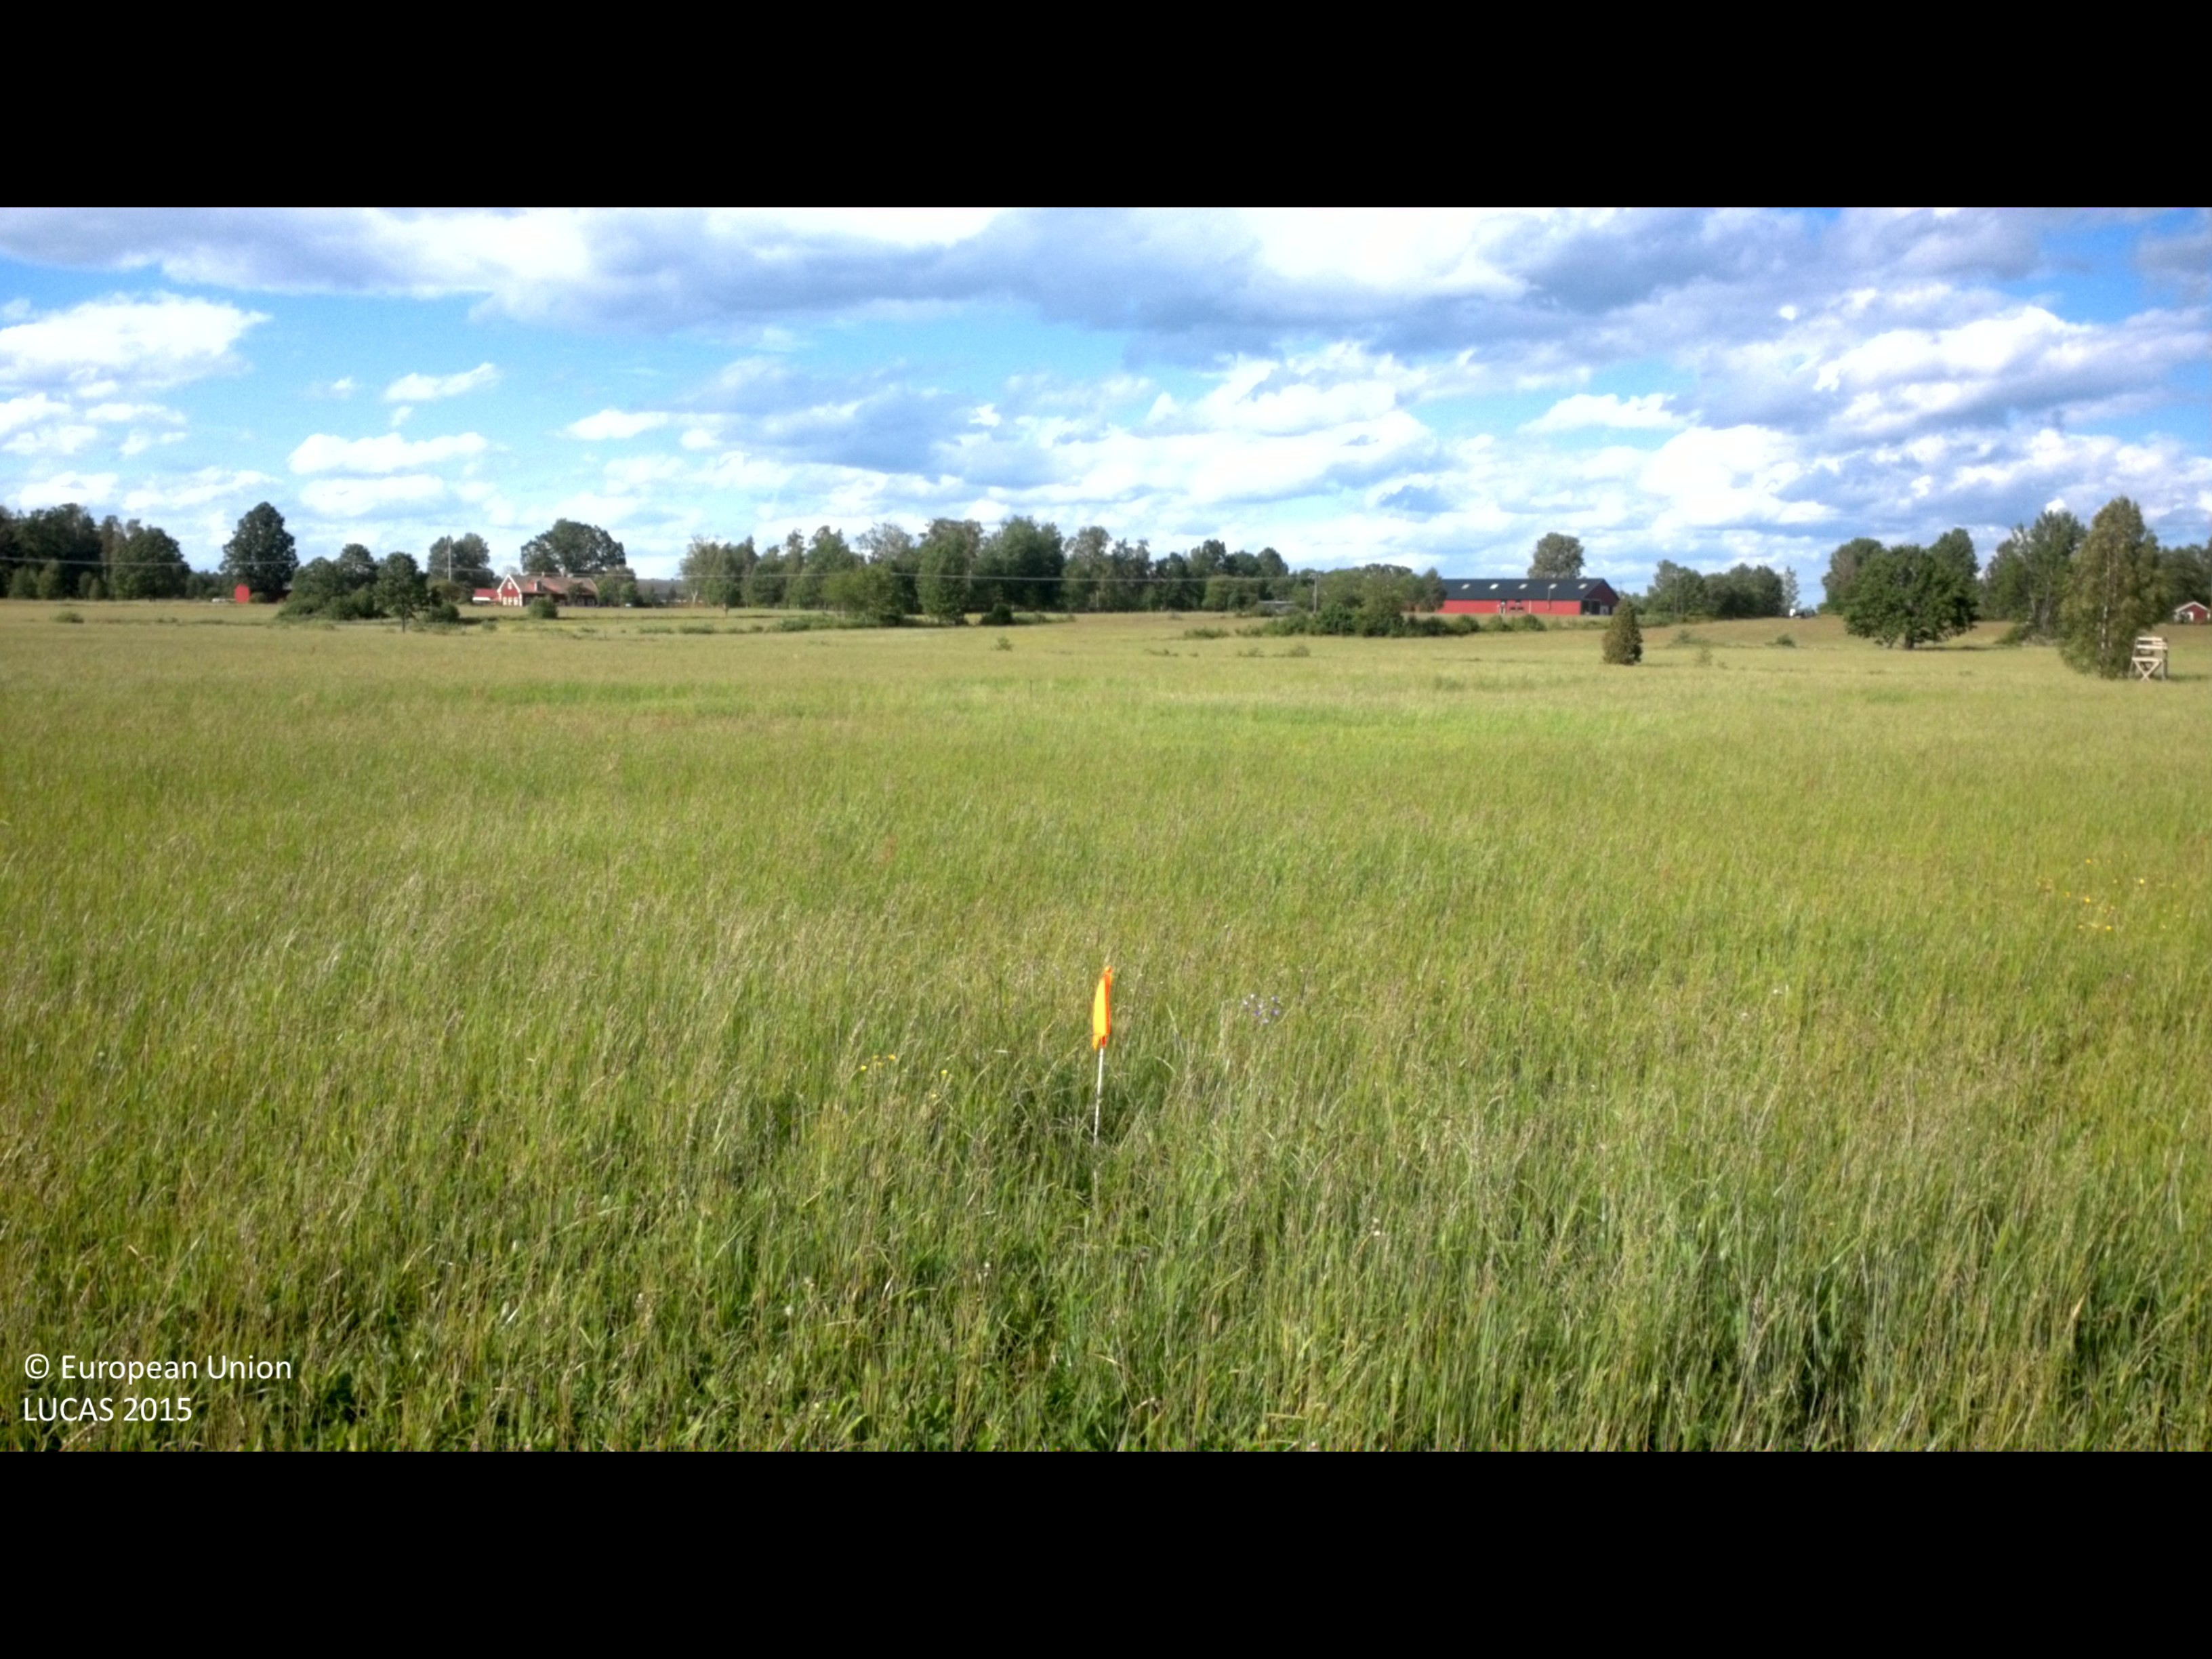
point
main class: Grassland
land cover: Grassland without tree/shrub cover
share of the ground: > 75 %
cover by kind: herbaceous plants 100 %
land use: Agriculture (excluding fallow land and kitchen gardens)
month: June
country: SE
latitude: 57.7715
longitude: 16.5385
